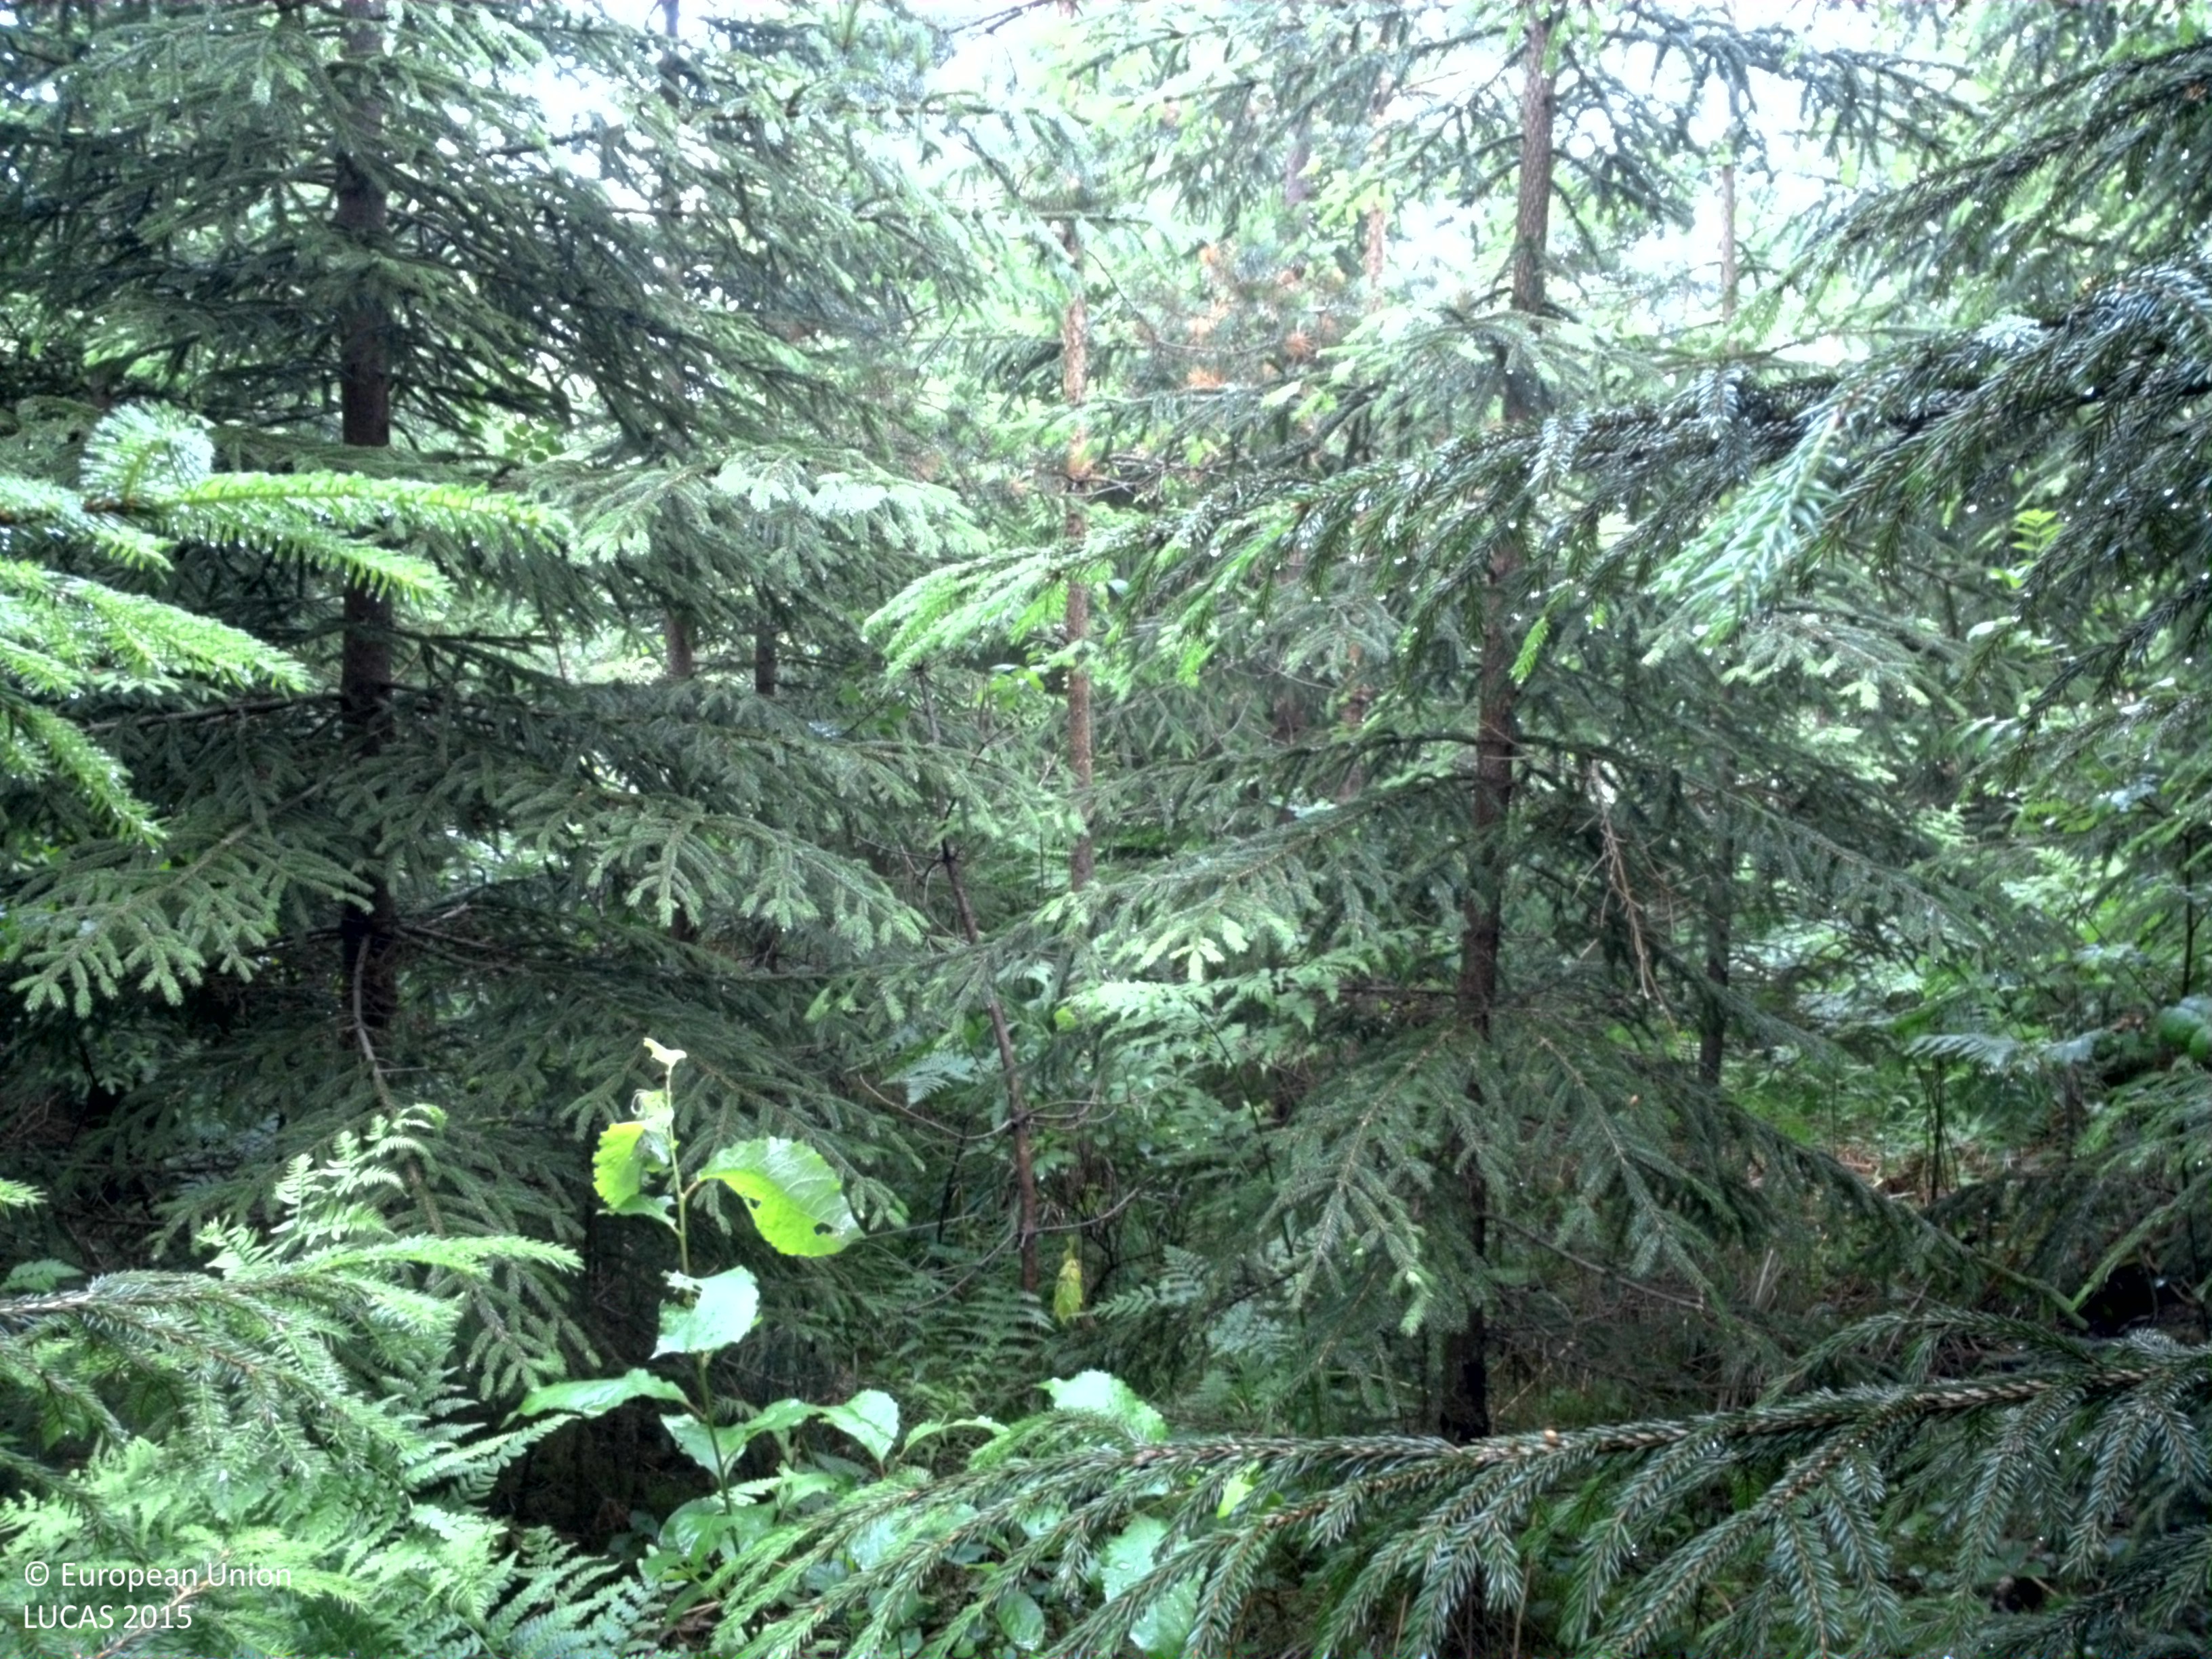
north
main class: Woodland
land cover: Spruce dominated coniferous woodland
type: boreal forest
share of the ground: > 75 %
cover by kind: coniferous forest trees 90 %, herbaceous plants 10 %
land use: Forestry
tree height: < 5 m
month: July
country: SE
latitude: 59.9934
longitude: 18.5489
